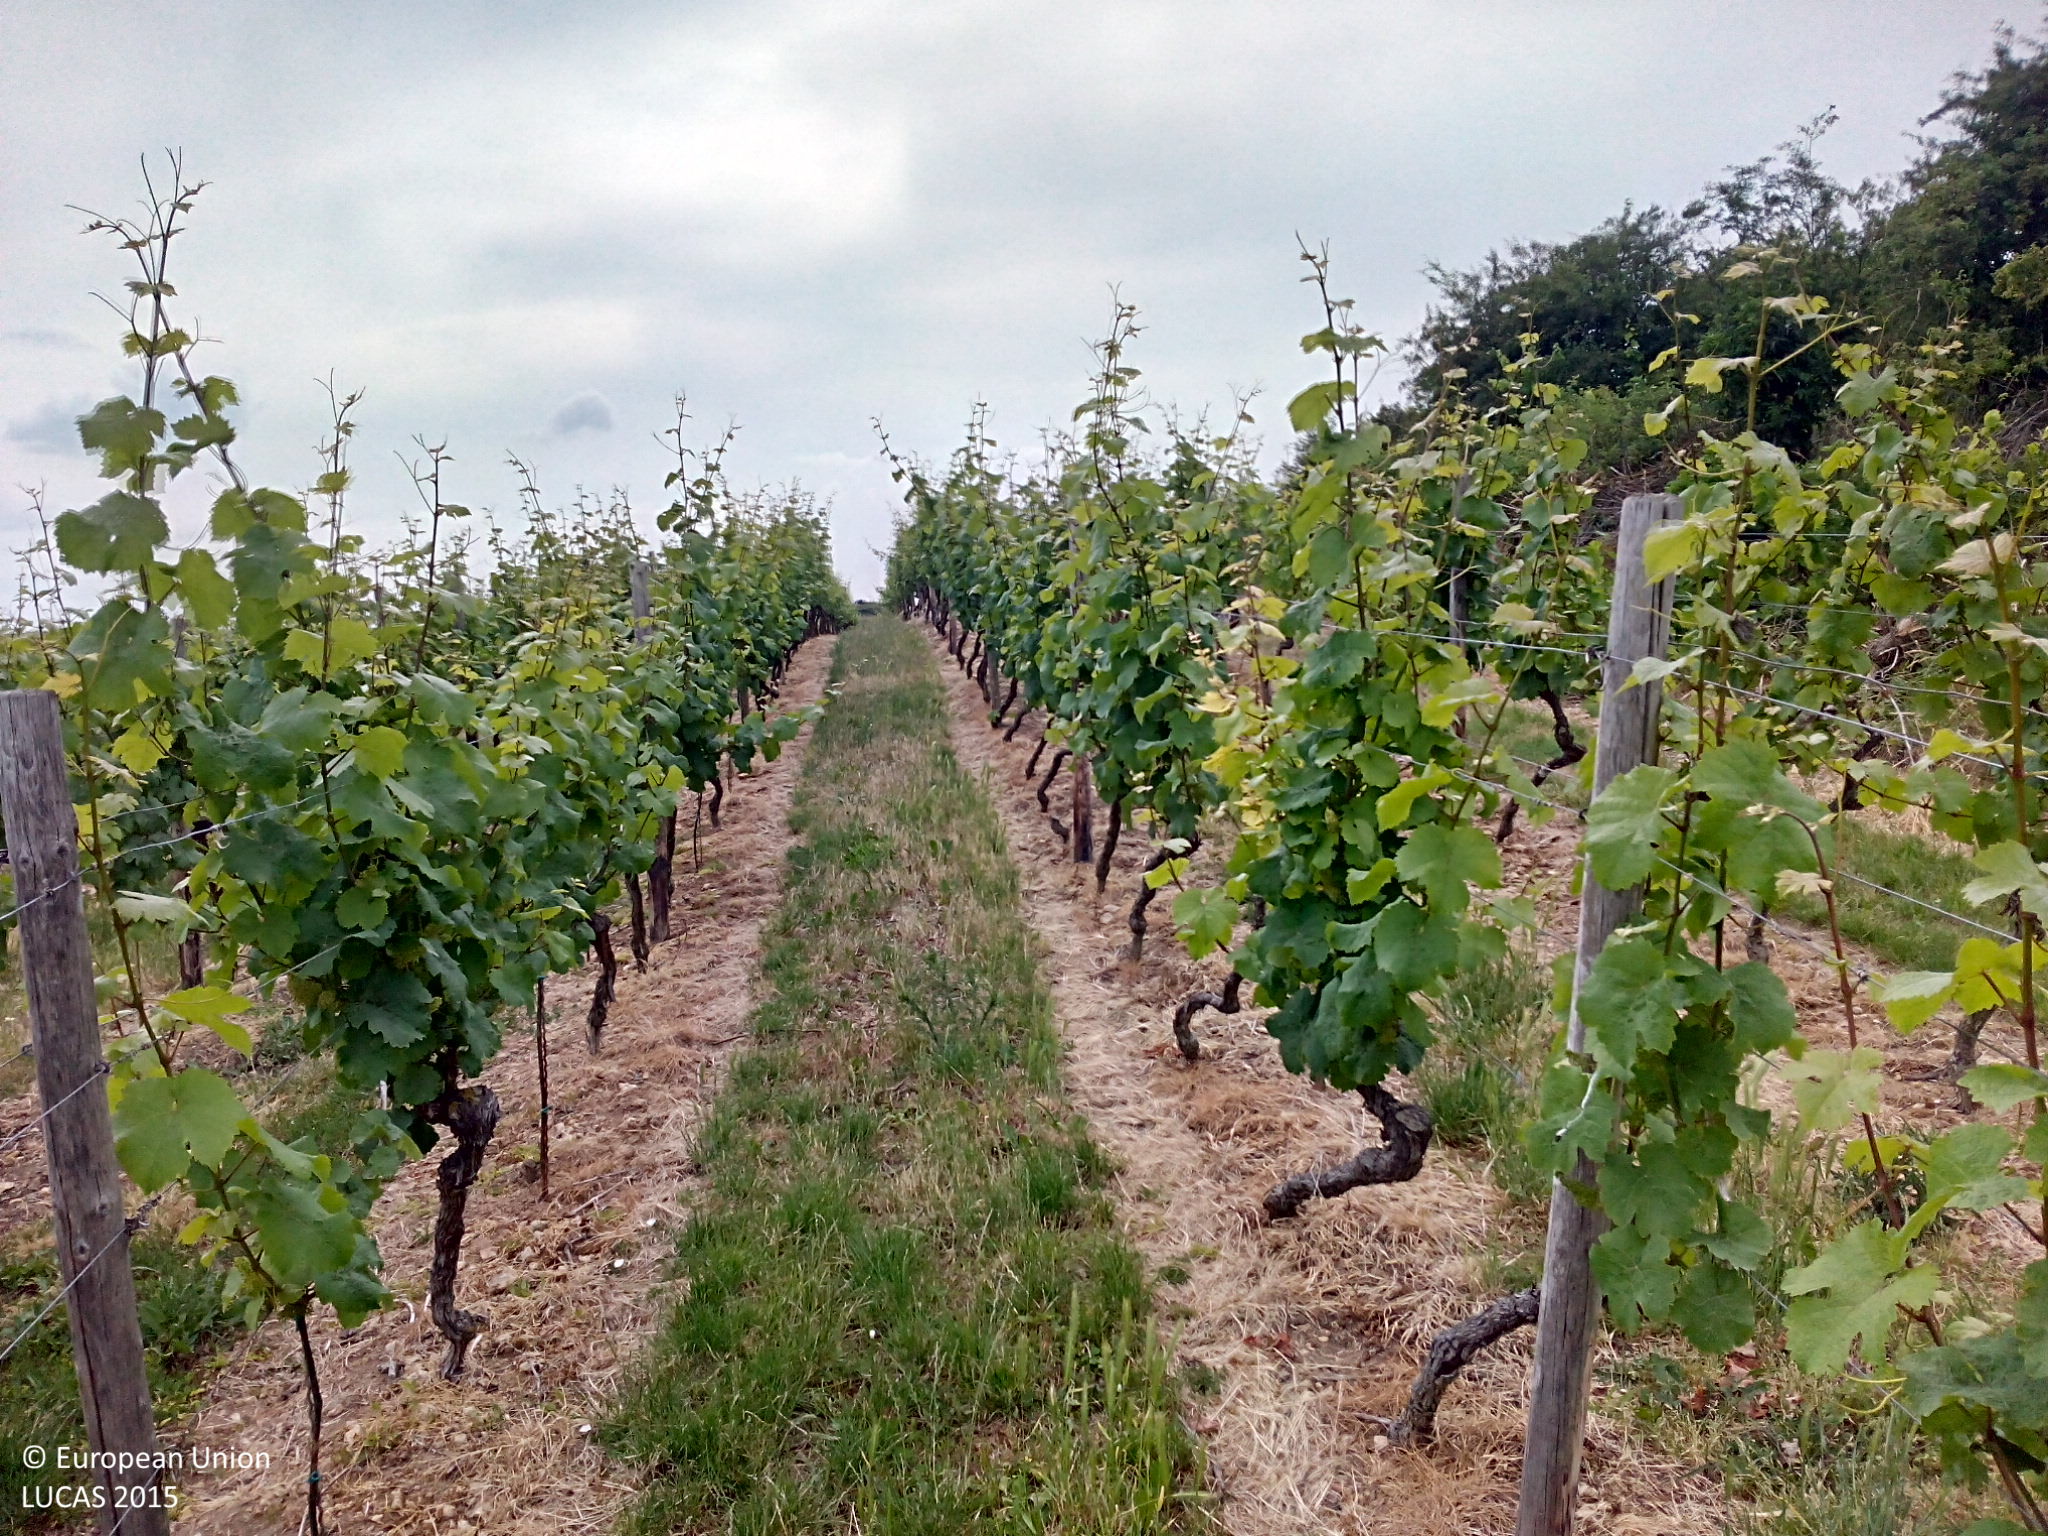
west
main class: Cropland
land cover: Vineyards
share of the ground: 10 - 25 %
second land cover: Grassland without tree/shrub cover
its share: 25 - 50 %
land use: Agriculture (excluding fallow land and kitchen gardens)
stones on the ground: 25 - 50 %
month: June
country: DE
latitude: 49.5938
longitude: 8.1605
